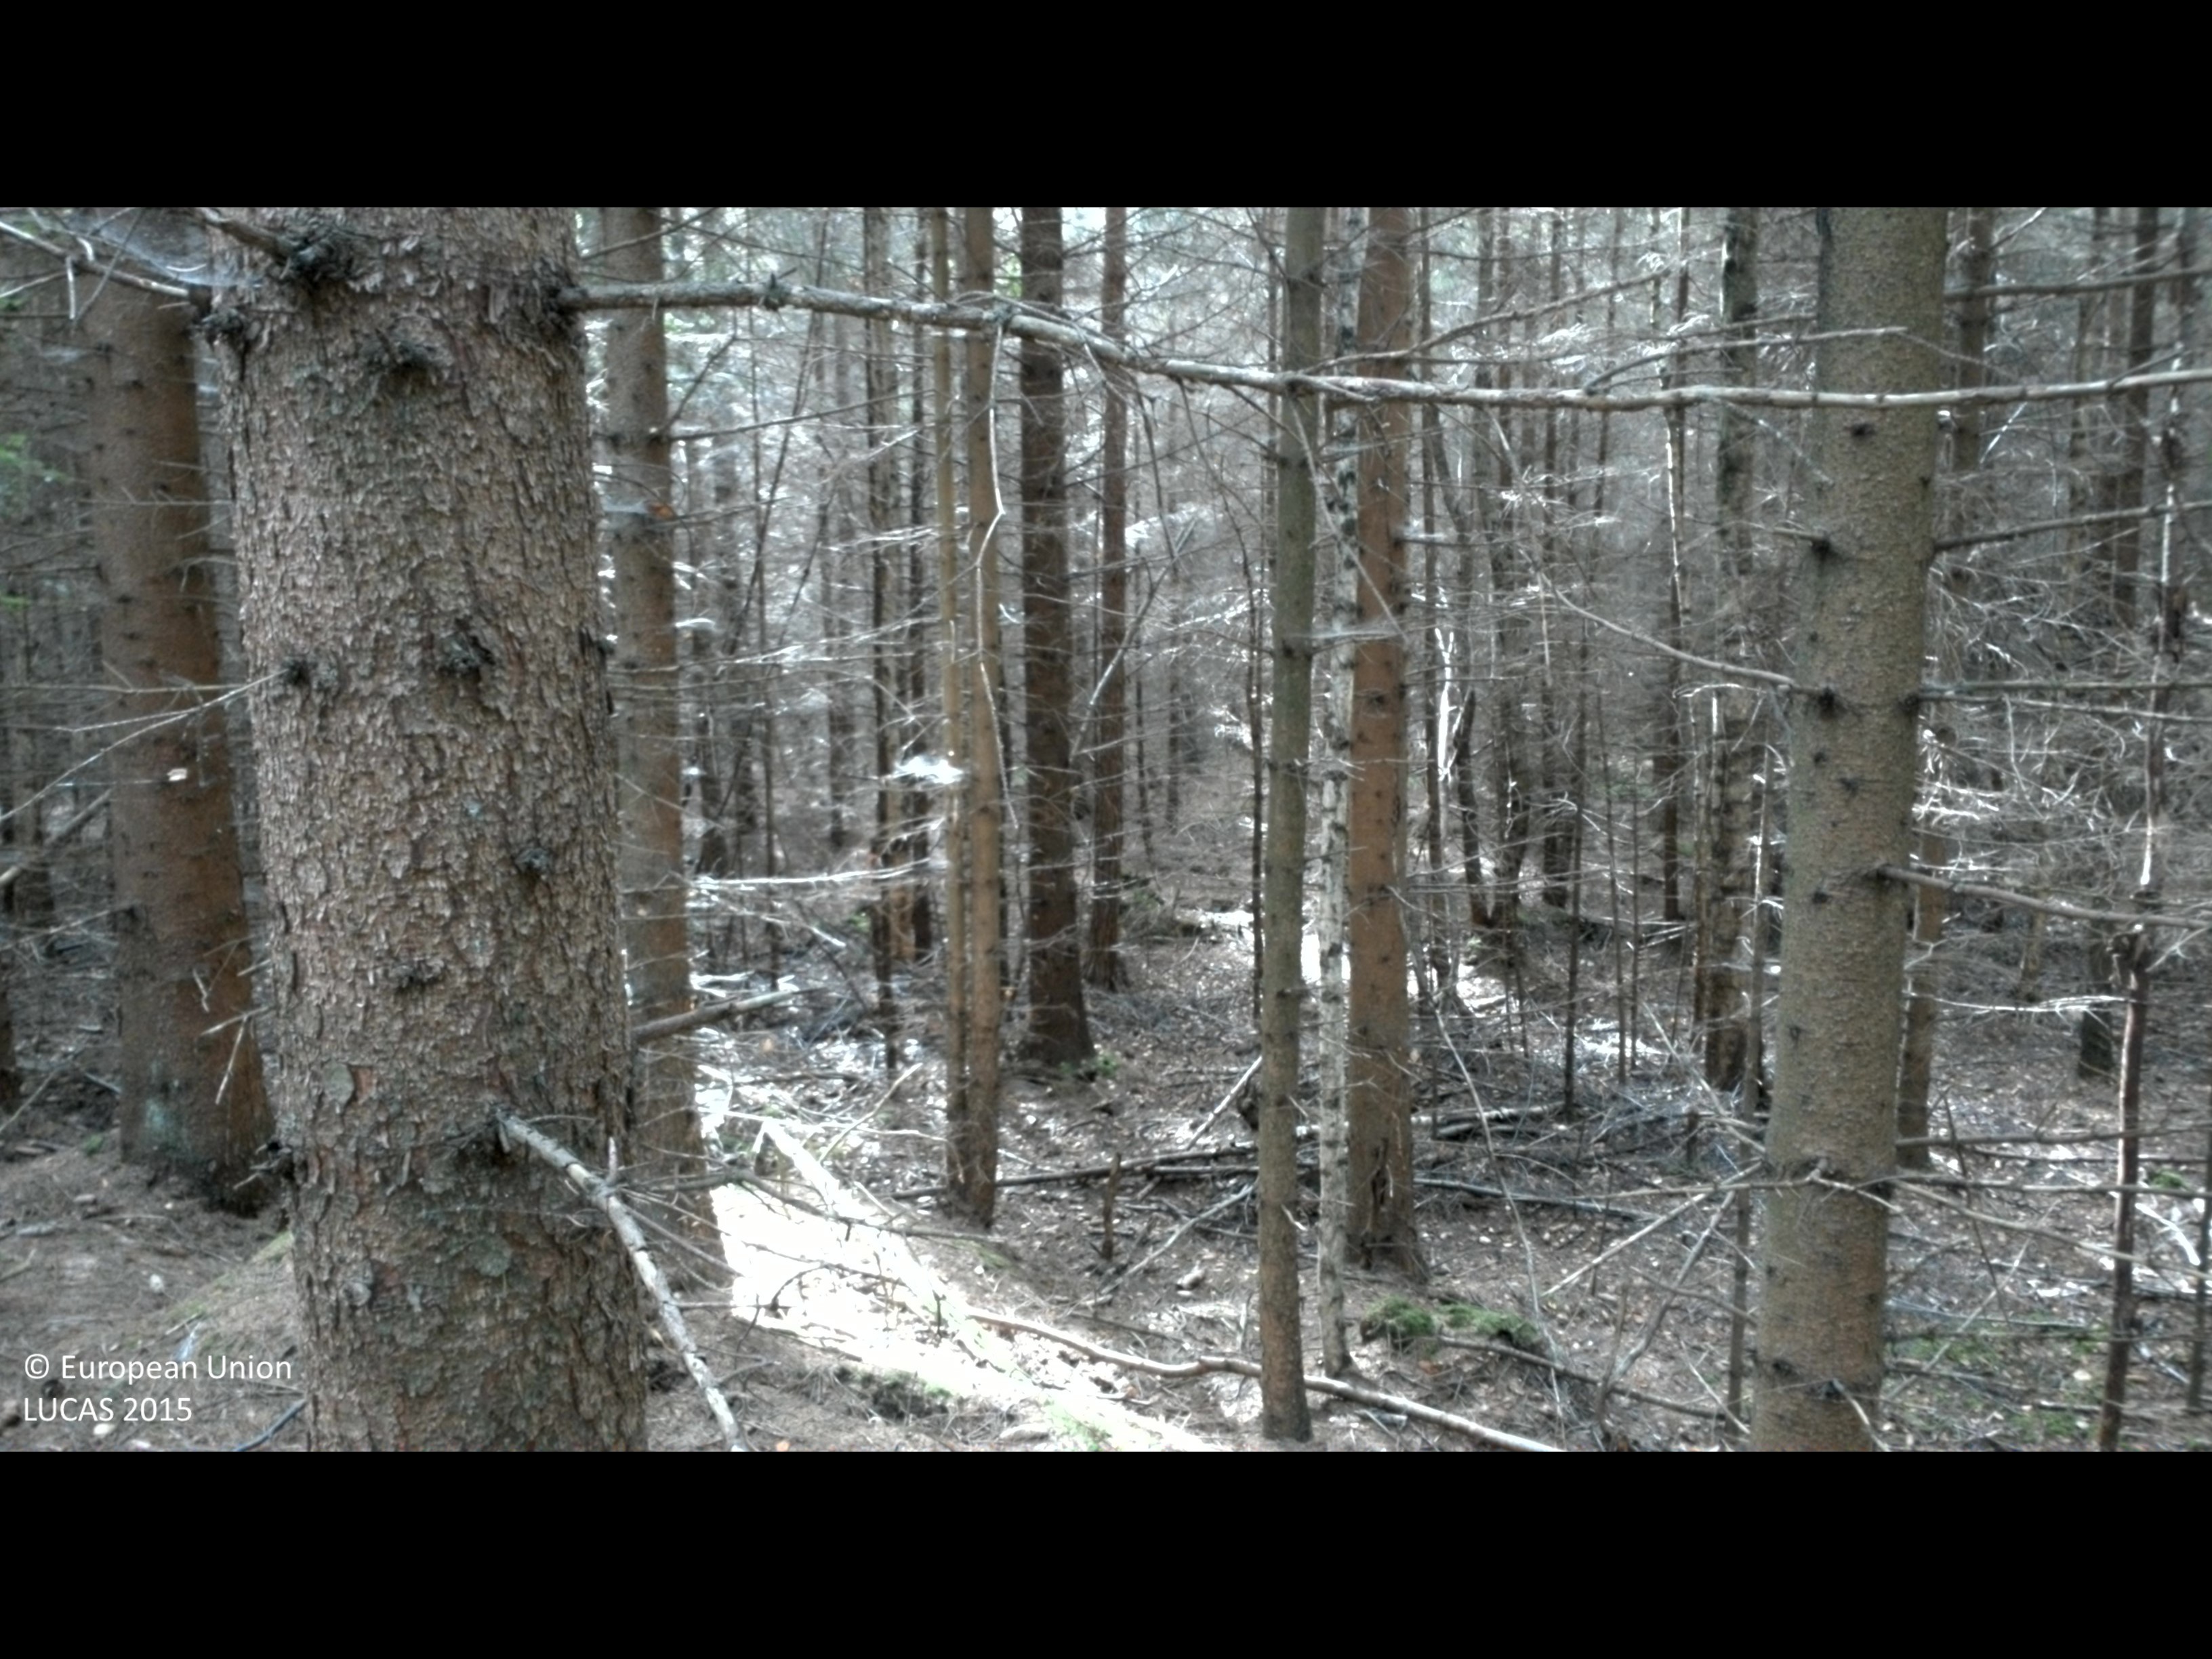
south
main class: Woodland
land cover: Spruce dominated coniferous woodland
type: boreal forest
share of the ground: > 75 %
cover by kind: coniferous forest trees 75 %, lichens and mosses 20 %
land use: Forestry
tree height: > 5 m
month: August
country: SE
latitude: 56.3112
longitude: 14.3784
